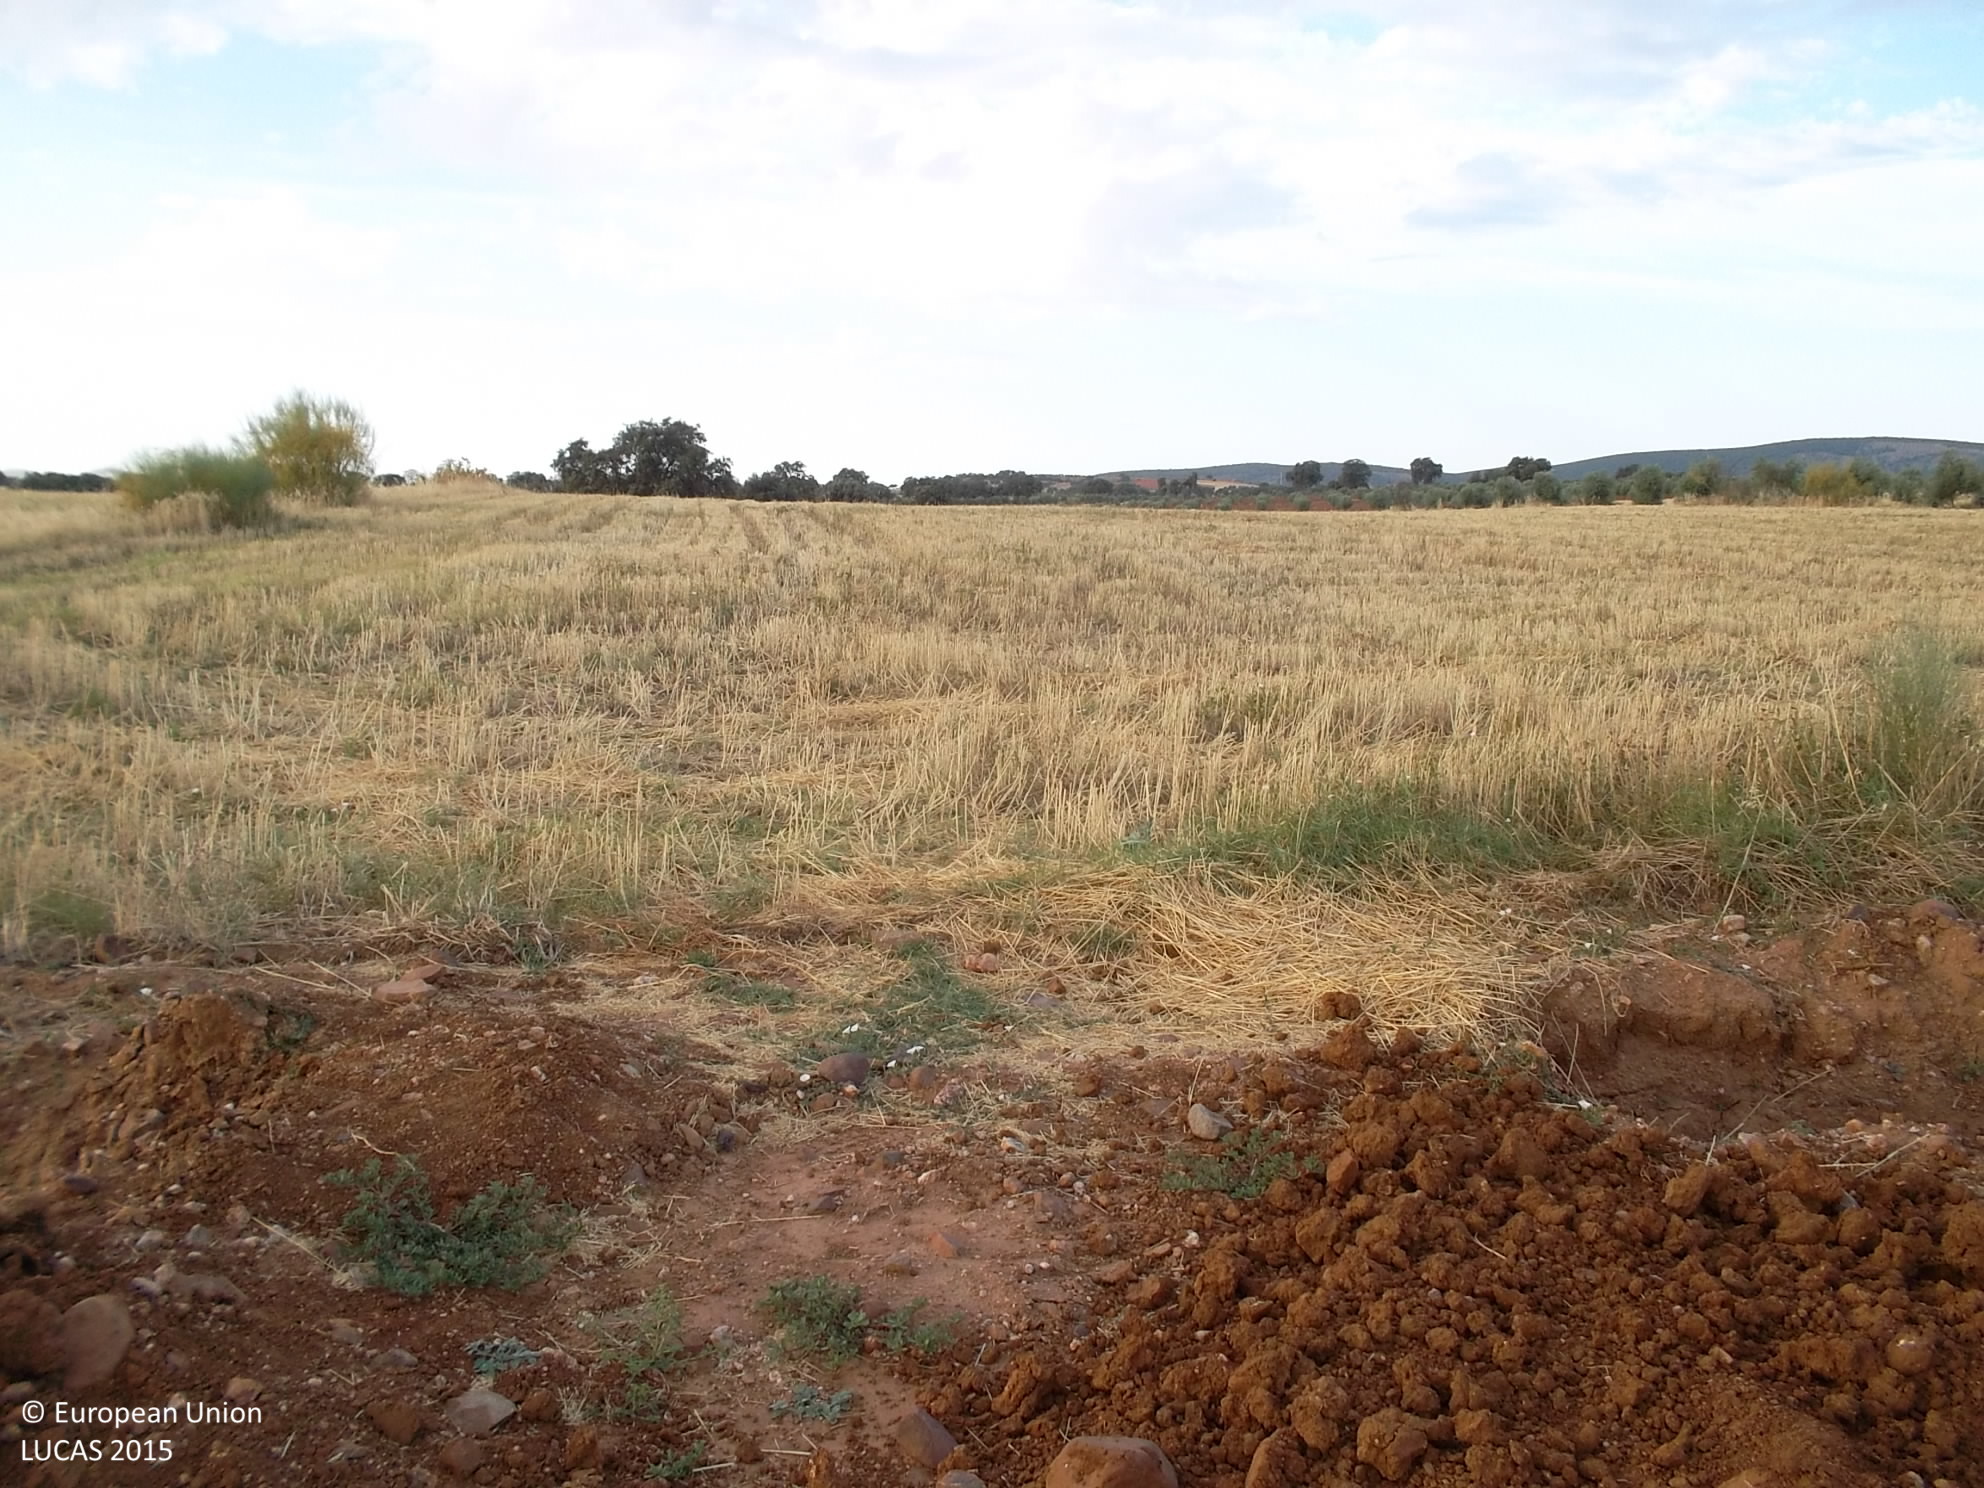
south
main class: Cropland
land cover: Olive groves
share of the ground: 10 - 25 %
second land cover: Other bare soil
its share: > 75 %
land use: Agriculture (excluding fallow land and kitchen gardens)
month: July
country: ES
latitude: 38.6002
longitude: -5.4105
